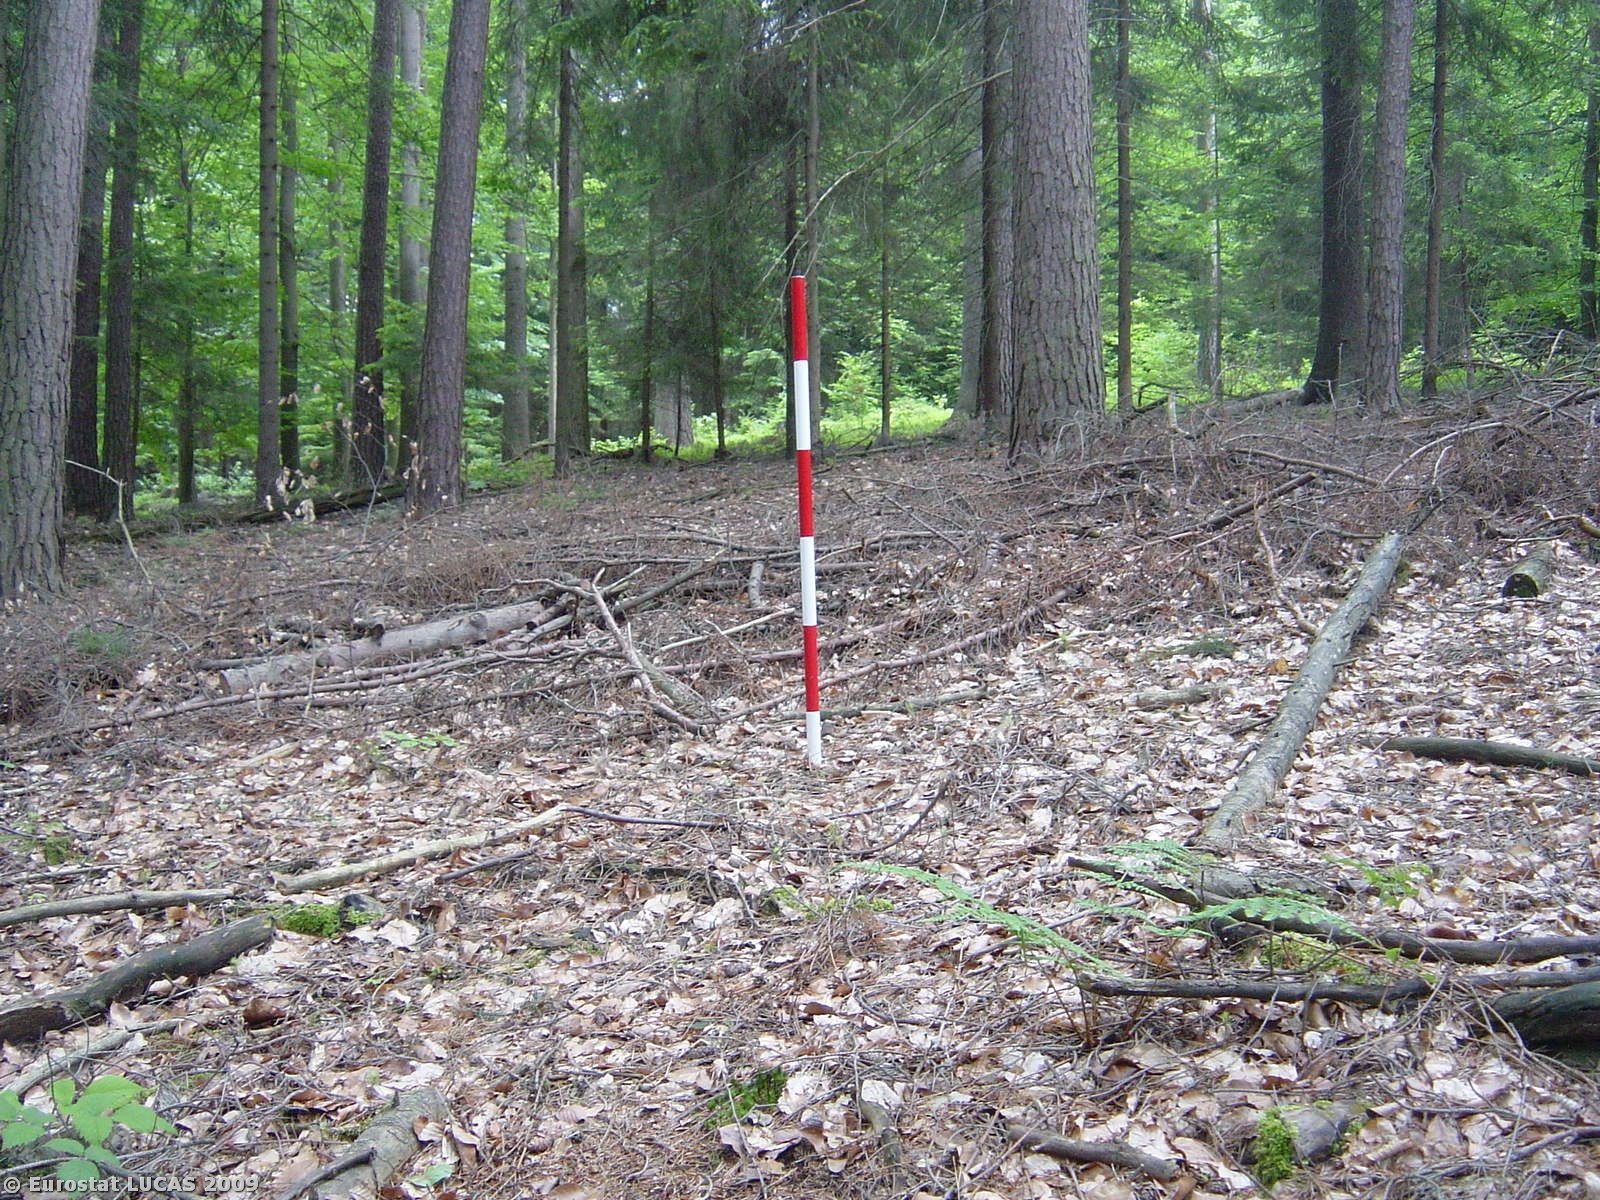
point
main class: Woodland
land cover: Mixed woodland
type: hemiboreal forest and nemoral coniferous forest and mixed broadleaved-coniferous forest
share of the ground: > 75 %
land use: Forestry
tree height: > 5 m
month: June
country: CZ
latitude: 49.8884
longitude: 16.5355
